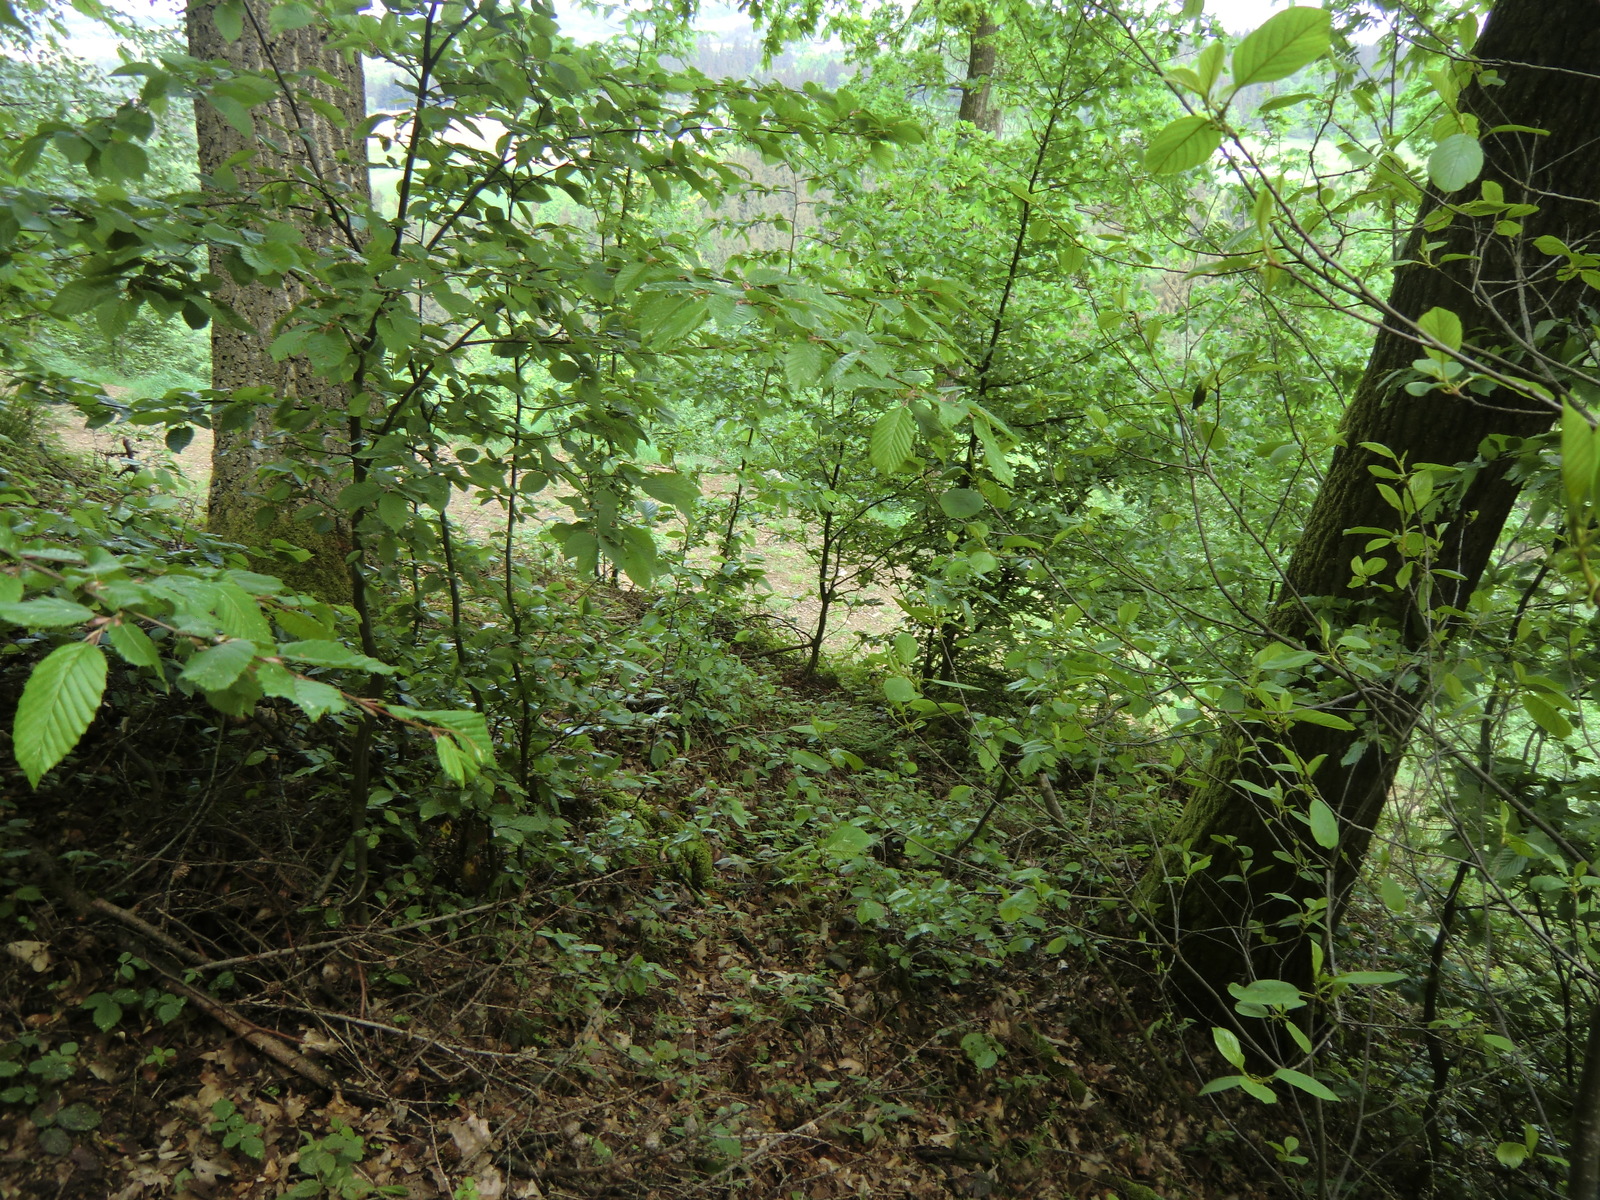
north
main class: Woodland
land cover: Spruce dominated mixed woodland
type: mountainous beech forest
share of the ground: > 75 %
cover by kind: broadleaved forest trees 30 %, shrubs 30 %, coniferous forest trees 20 %, herbaceous plants 10 %, unconsolidated bare surface 10 %
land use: Forestry
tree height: > 5 m
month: May
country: AT
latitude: 48.2709
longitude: 14.6219
